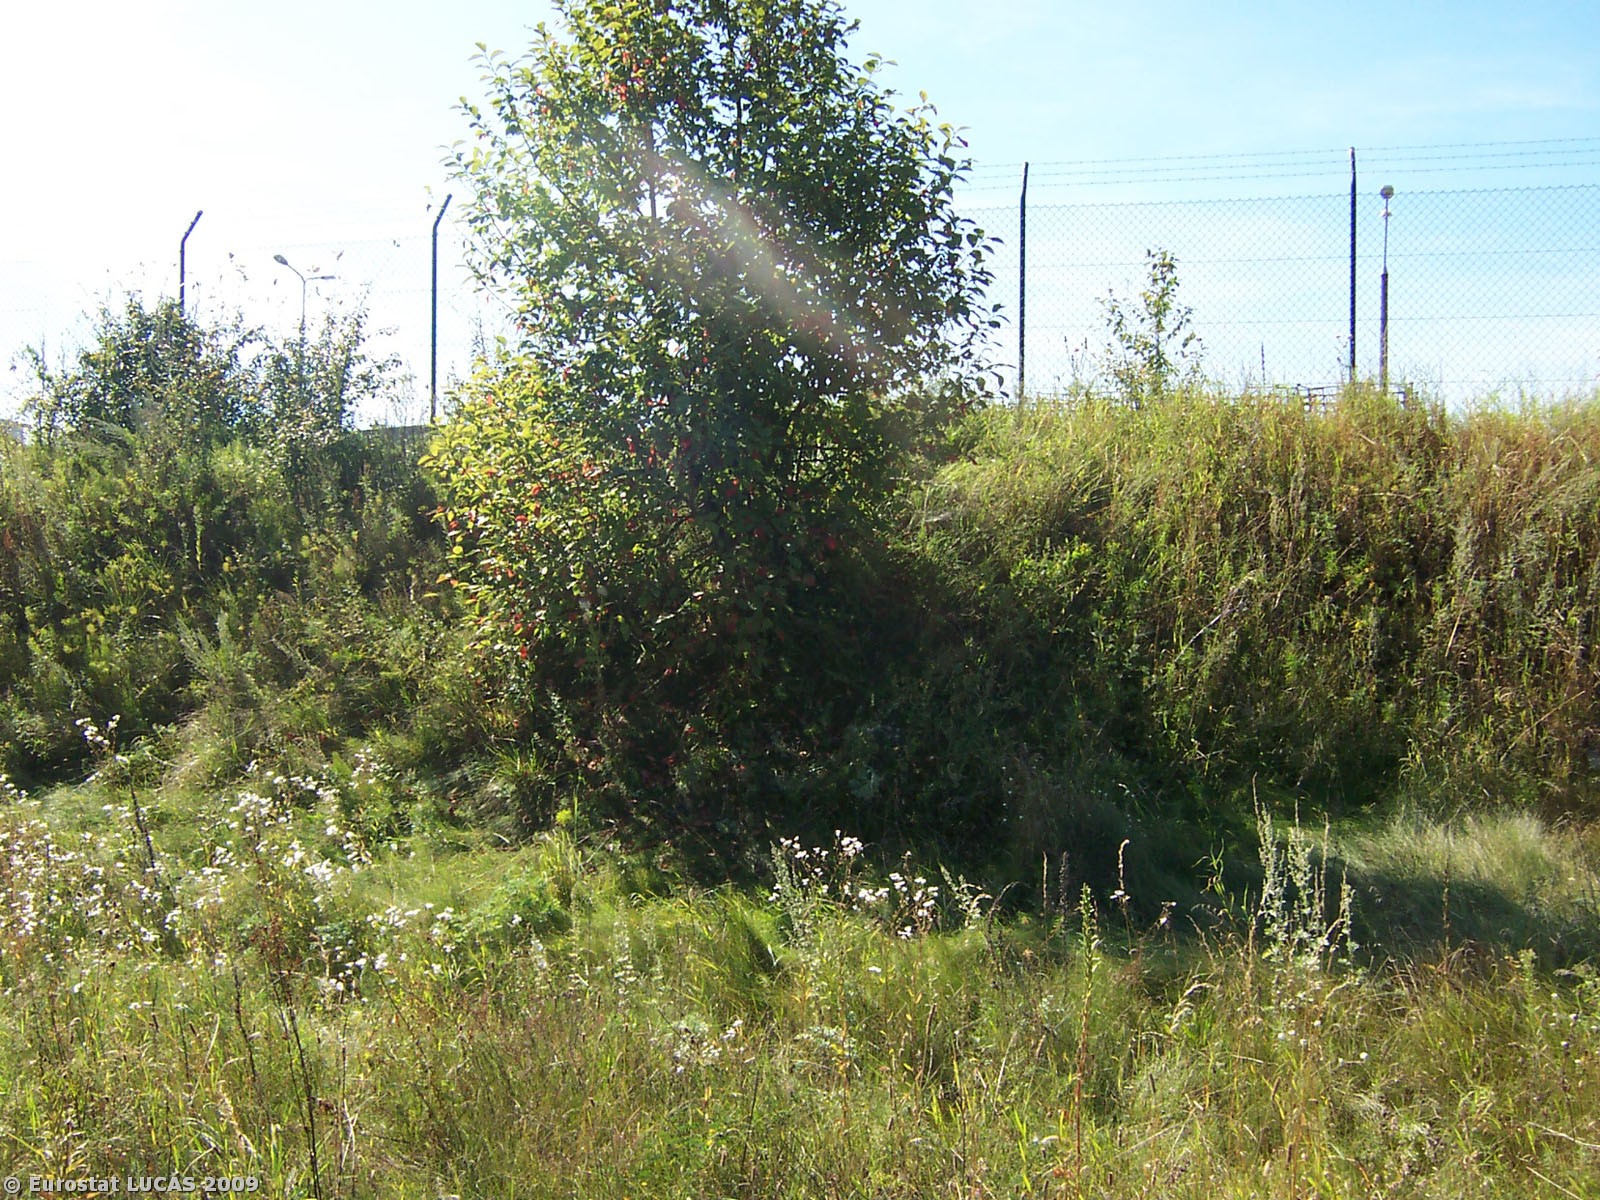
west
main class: Grassland
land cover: Grassland without tree/shrub cover
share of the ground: > 75 %
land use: Fallow land
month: August
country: PL
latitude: 52.7054
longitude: 22.0619
